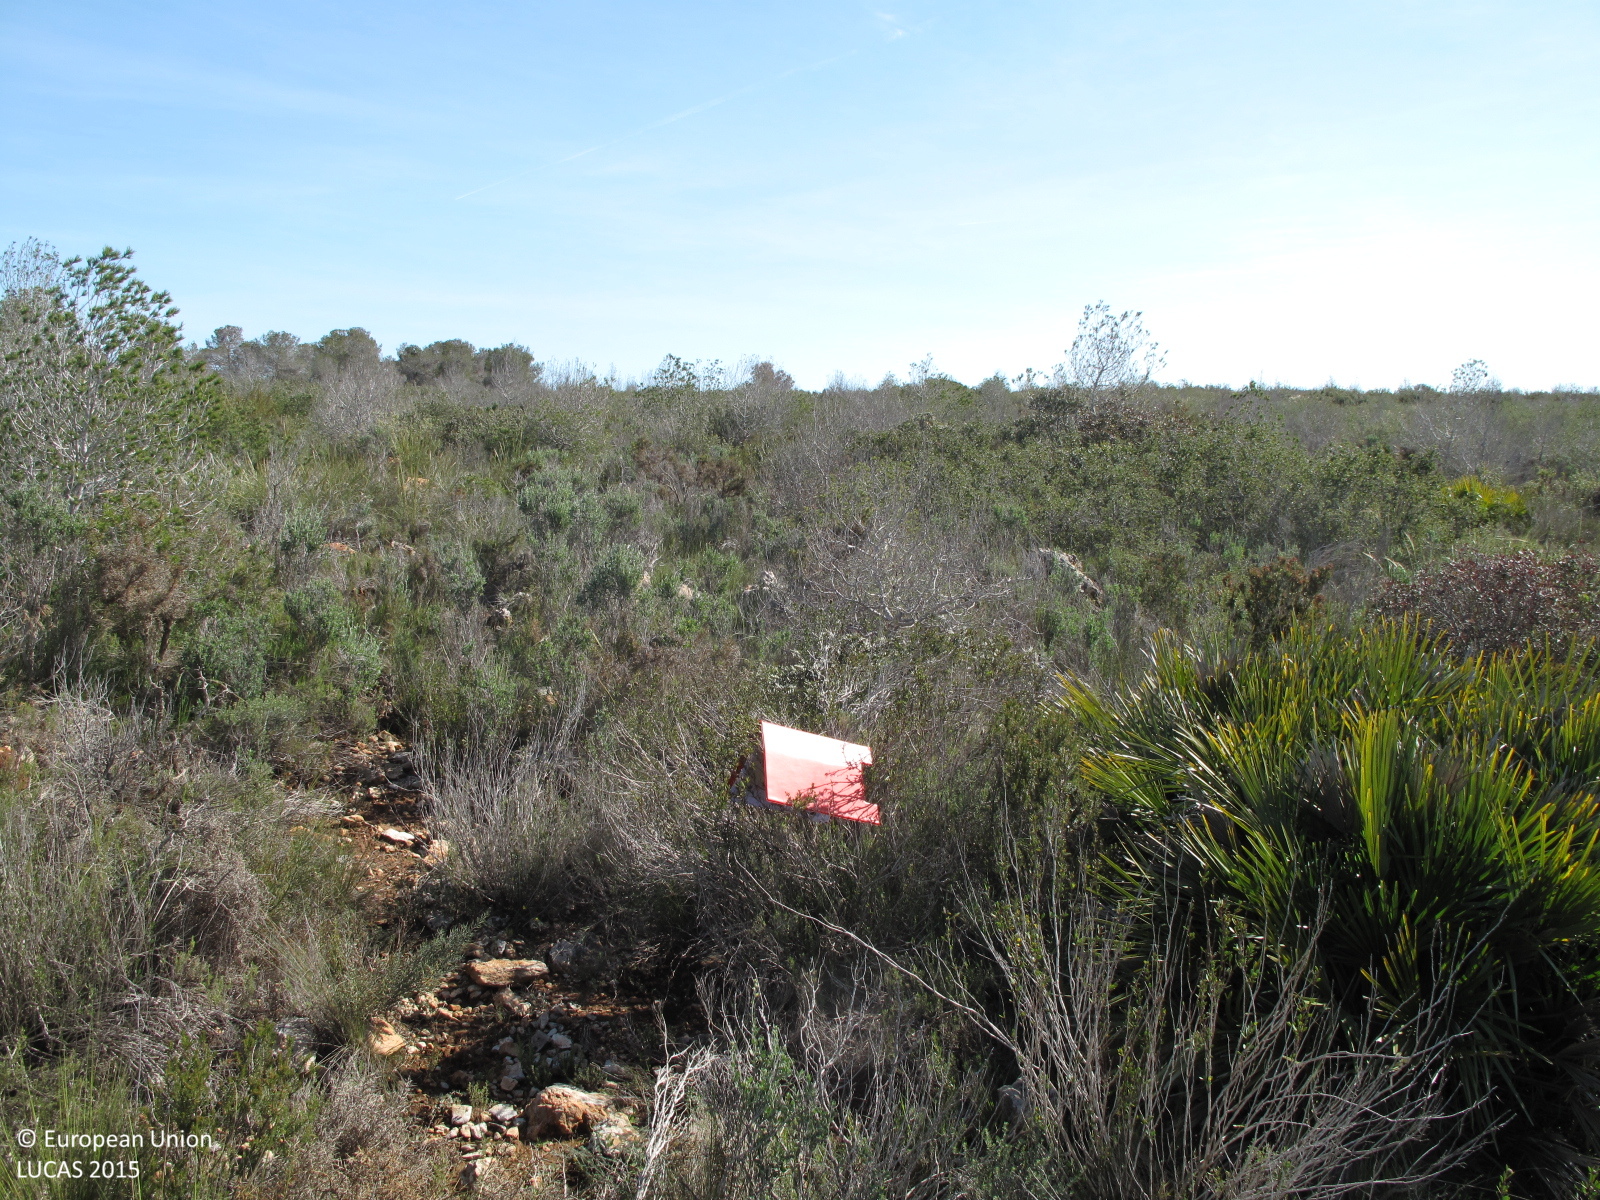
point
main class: Shrubland
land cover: Shrubland with sparse tree cover
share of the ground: > 75 %
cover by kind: shrubs 85 %, herbaceous plants 10 %, coniferous forest trees 5 %
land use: Semi-natural and natural areas not in use
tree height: < 5 m
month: March
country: ES
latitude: 39.1412
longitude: -0.6274
